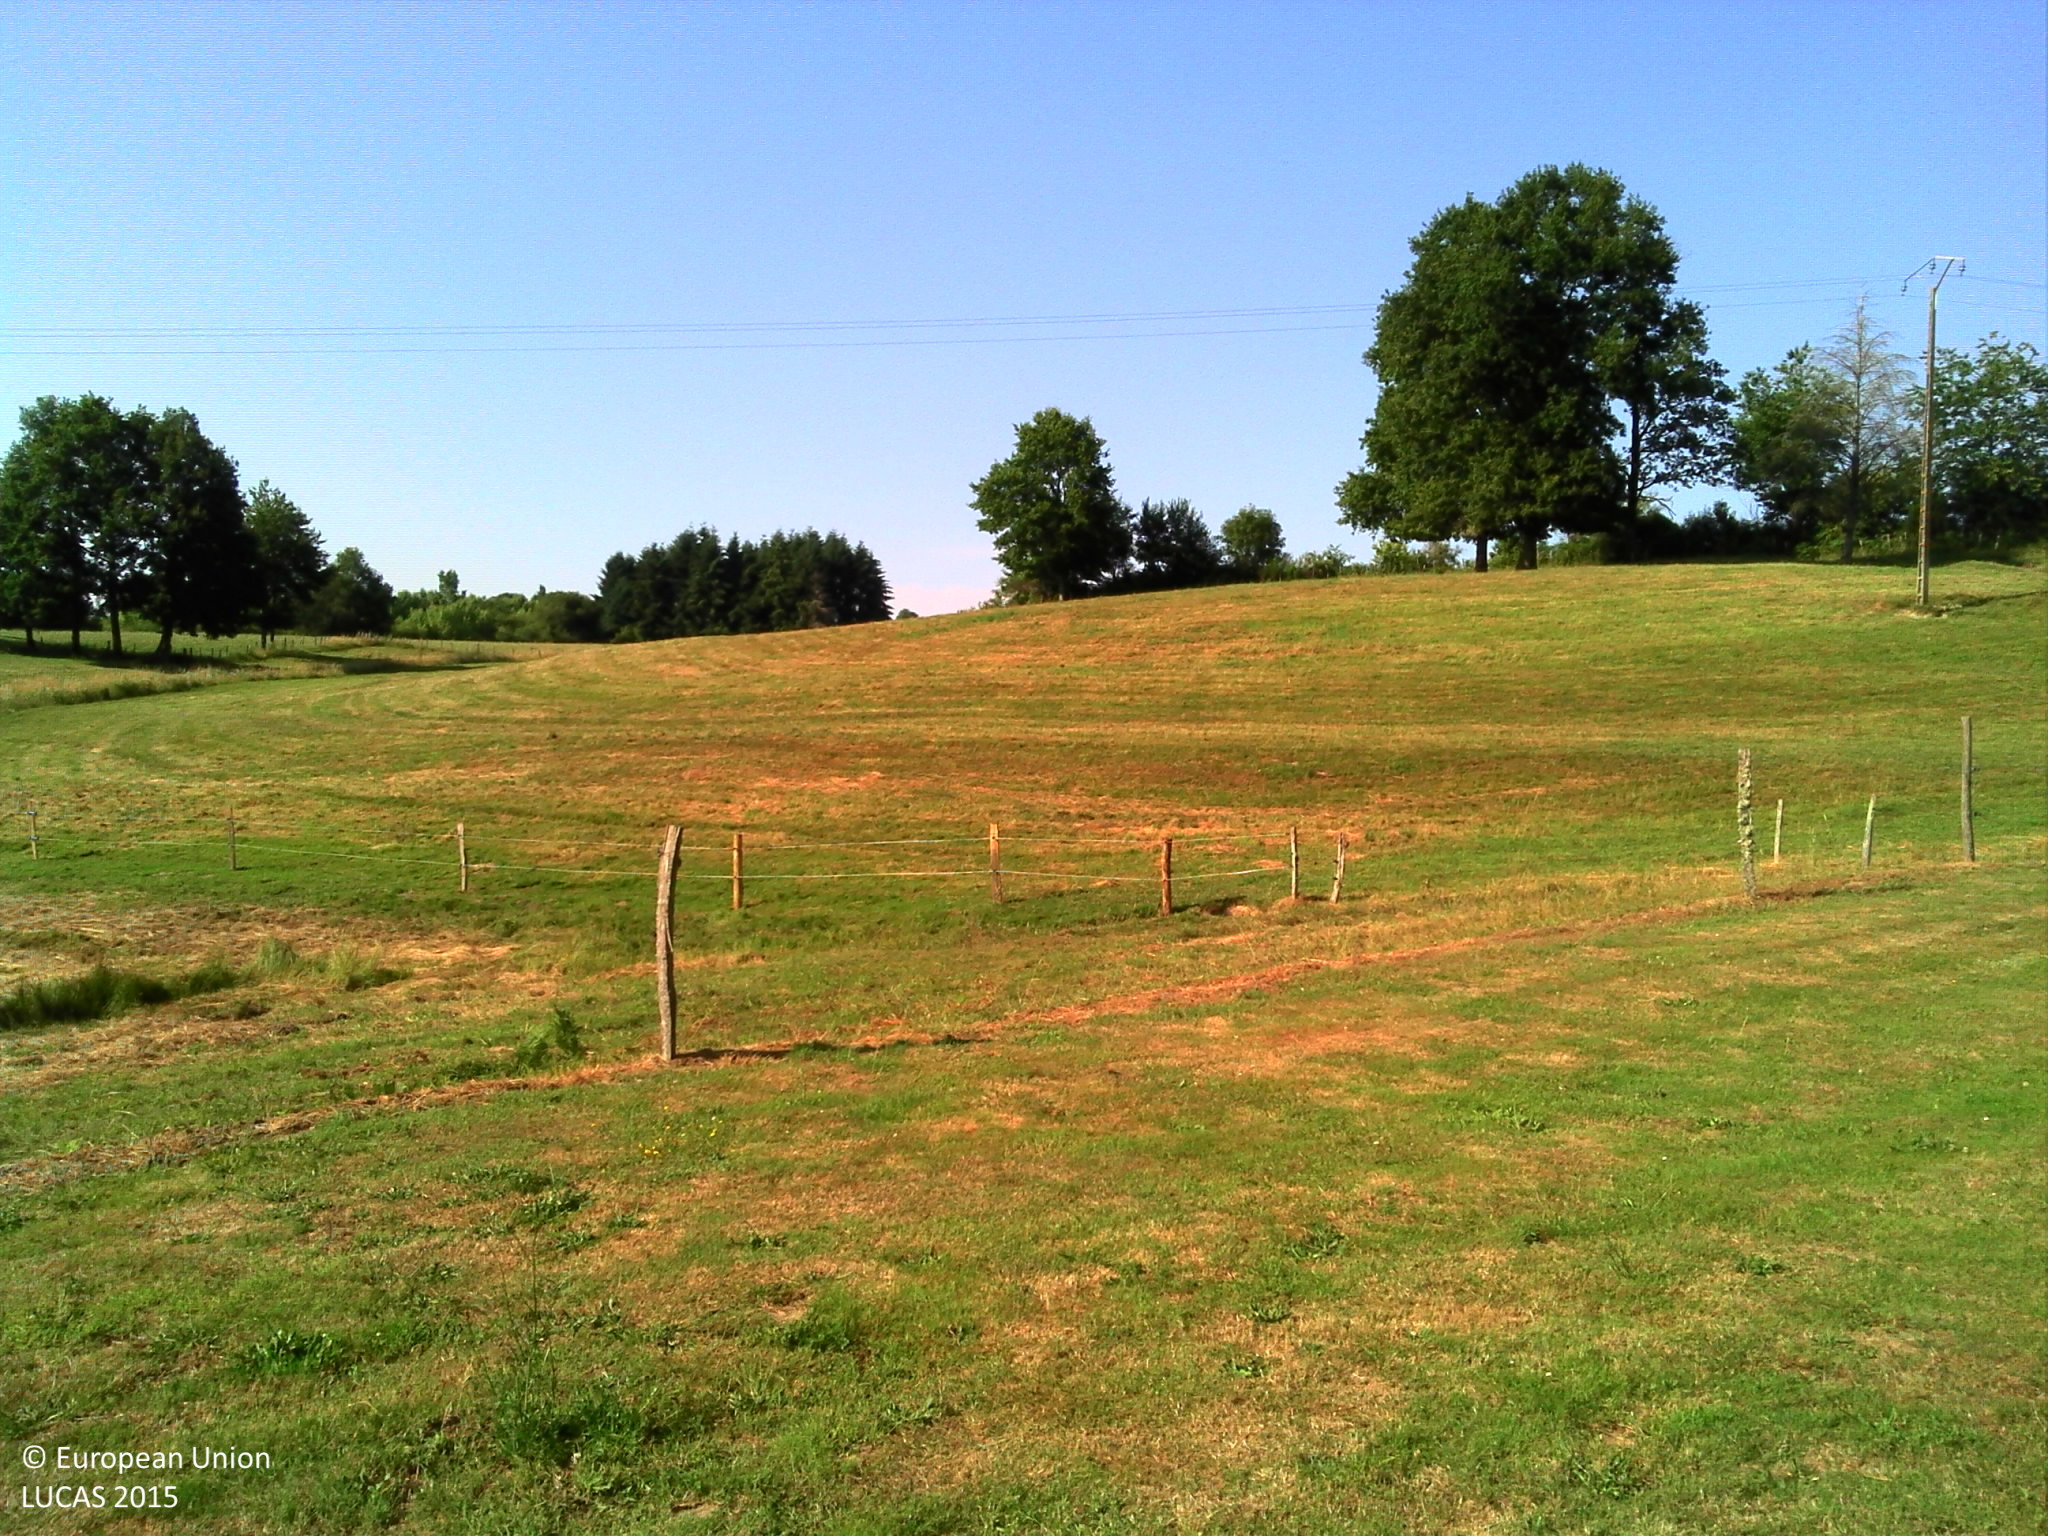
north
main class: Grassland
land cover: Grassland with sparse tree/shrub cover
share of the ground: > 75 %
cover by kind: herbaceous plants 95 %, broadleaved forest trees 5 %
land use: Residential
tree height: > 5 m
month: June
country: FR
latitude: 45.7363
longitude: 0.5922
